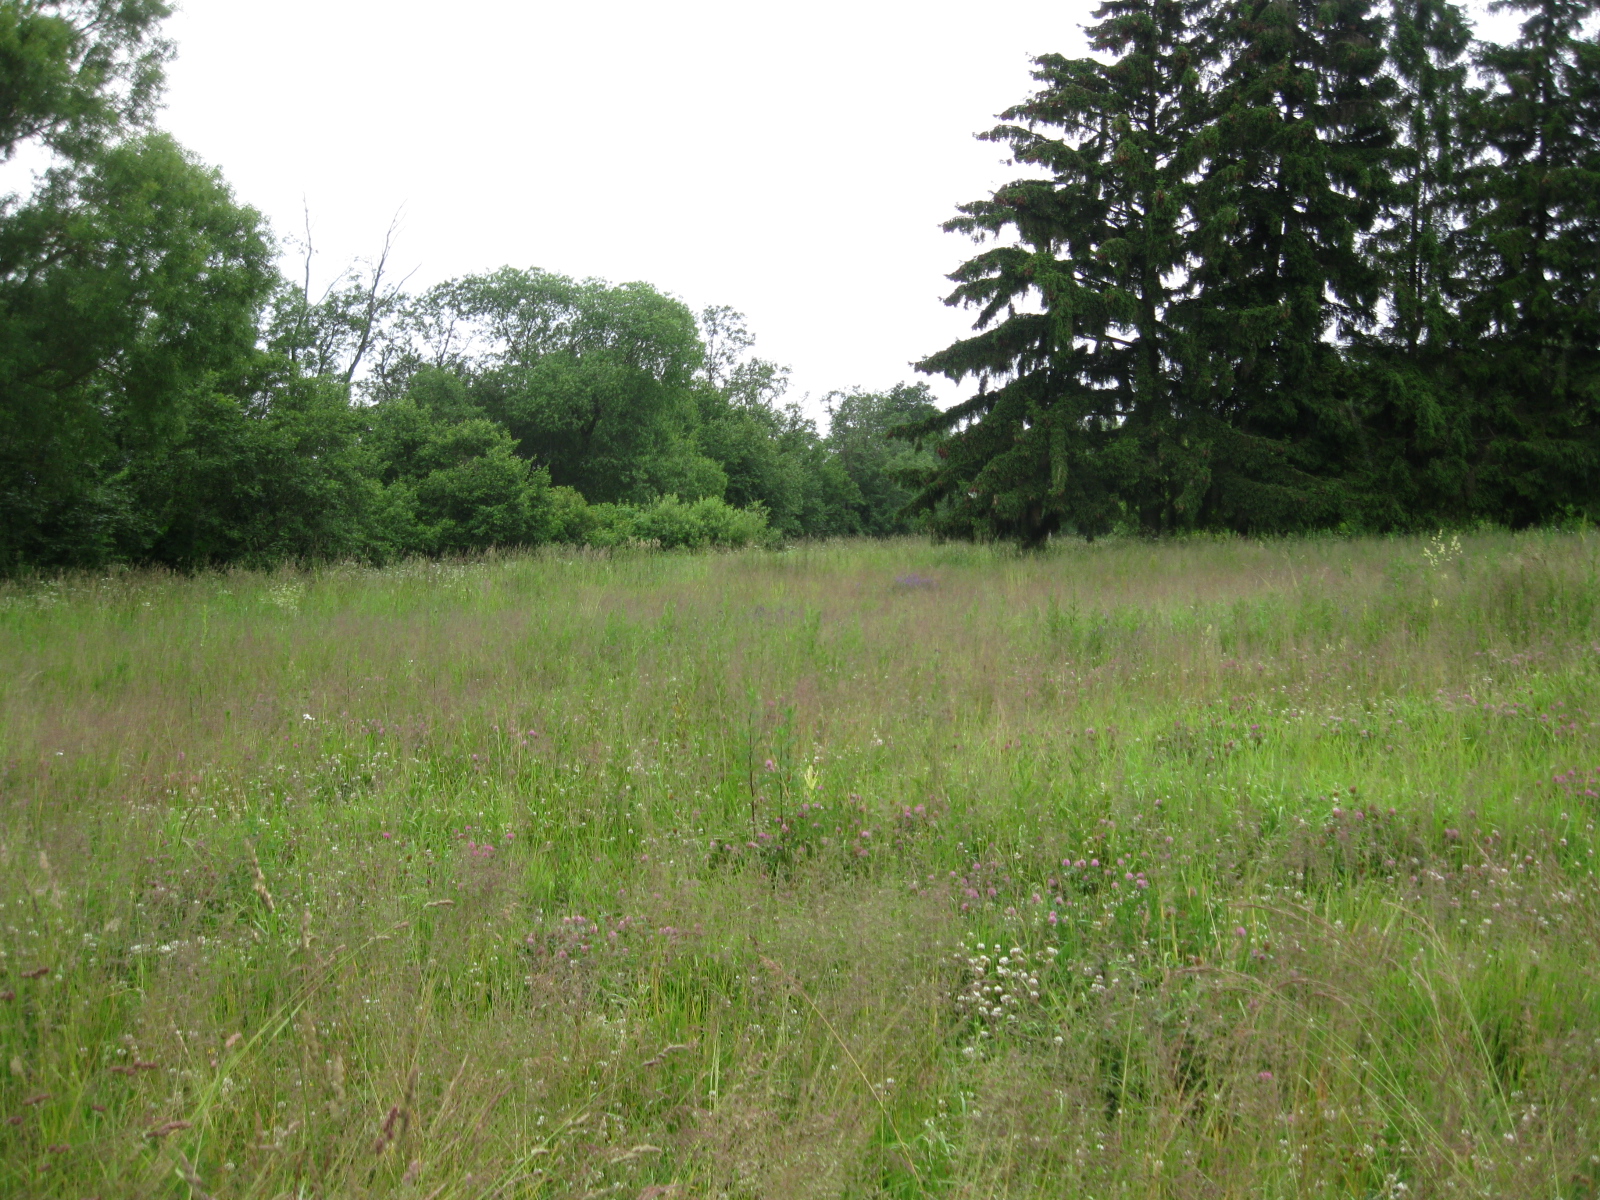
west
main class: Grassland
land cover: Grassland without tree/shrub cover
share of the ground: > 75 %
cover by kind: herbaceous plants 100 %
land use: Agriculture (excluding fallow land and kitchen gardens)
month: June
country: LT
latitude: 55.1894
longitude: 24.0550
